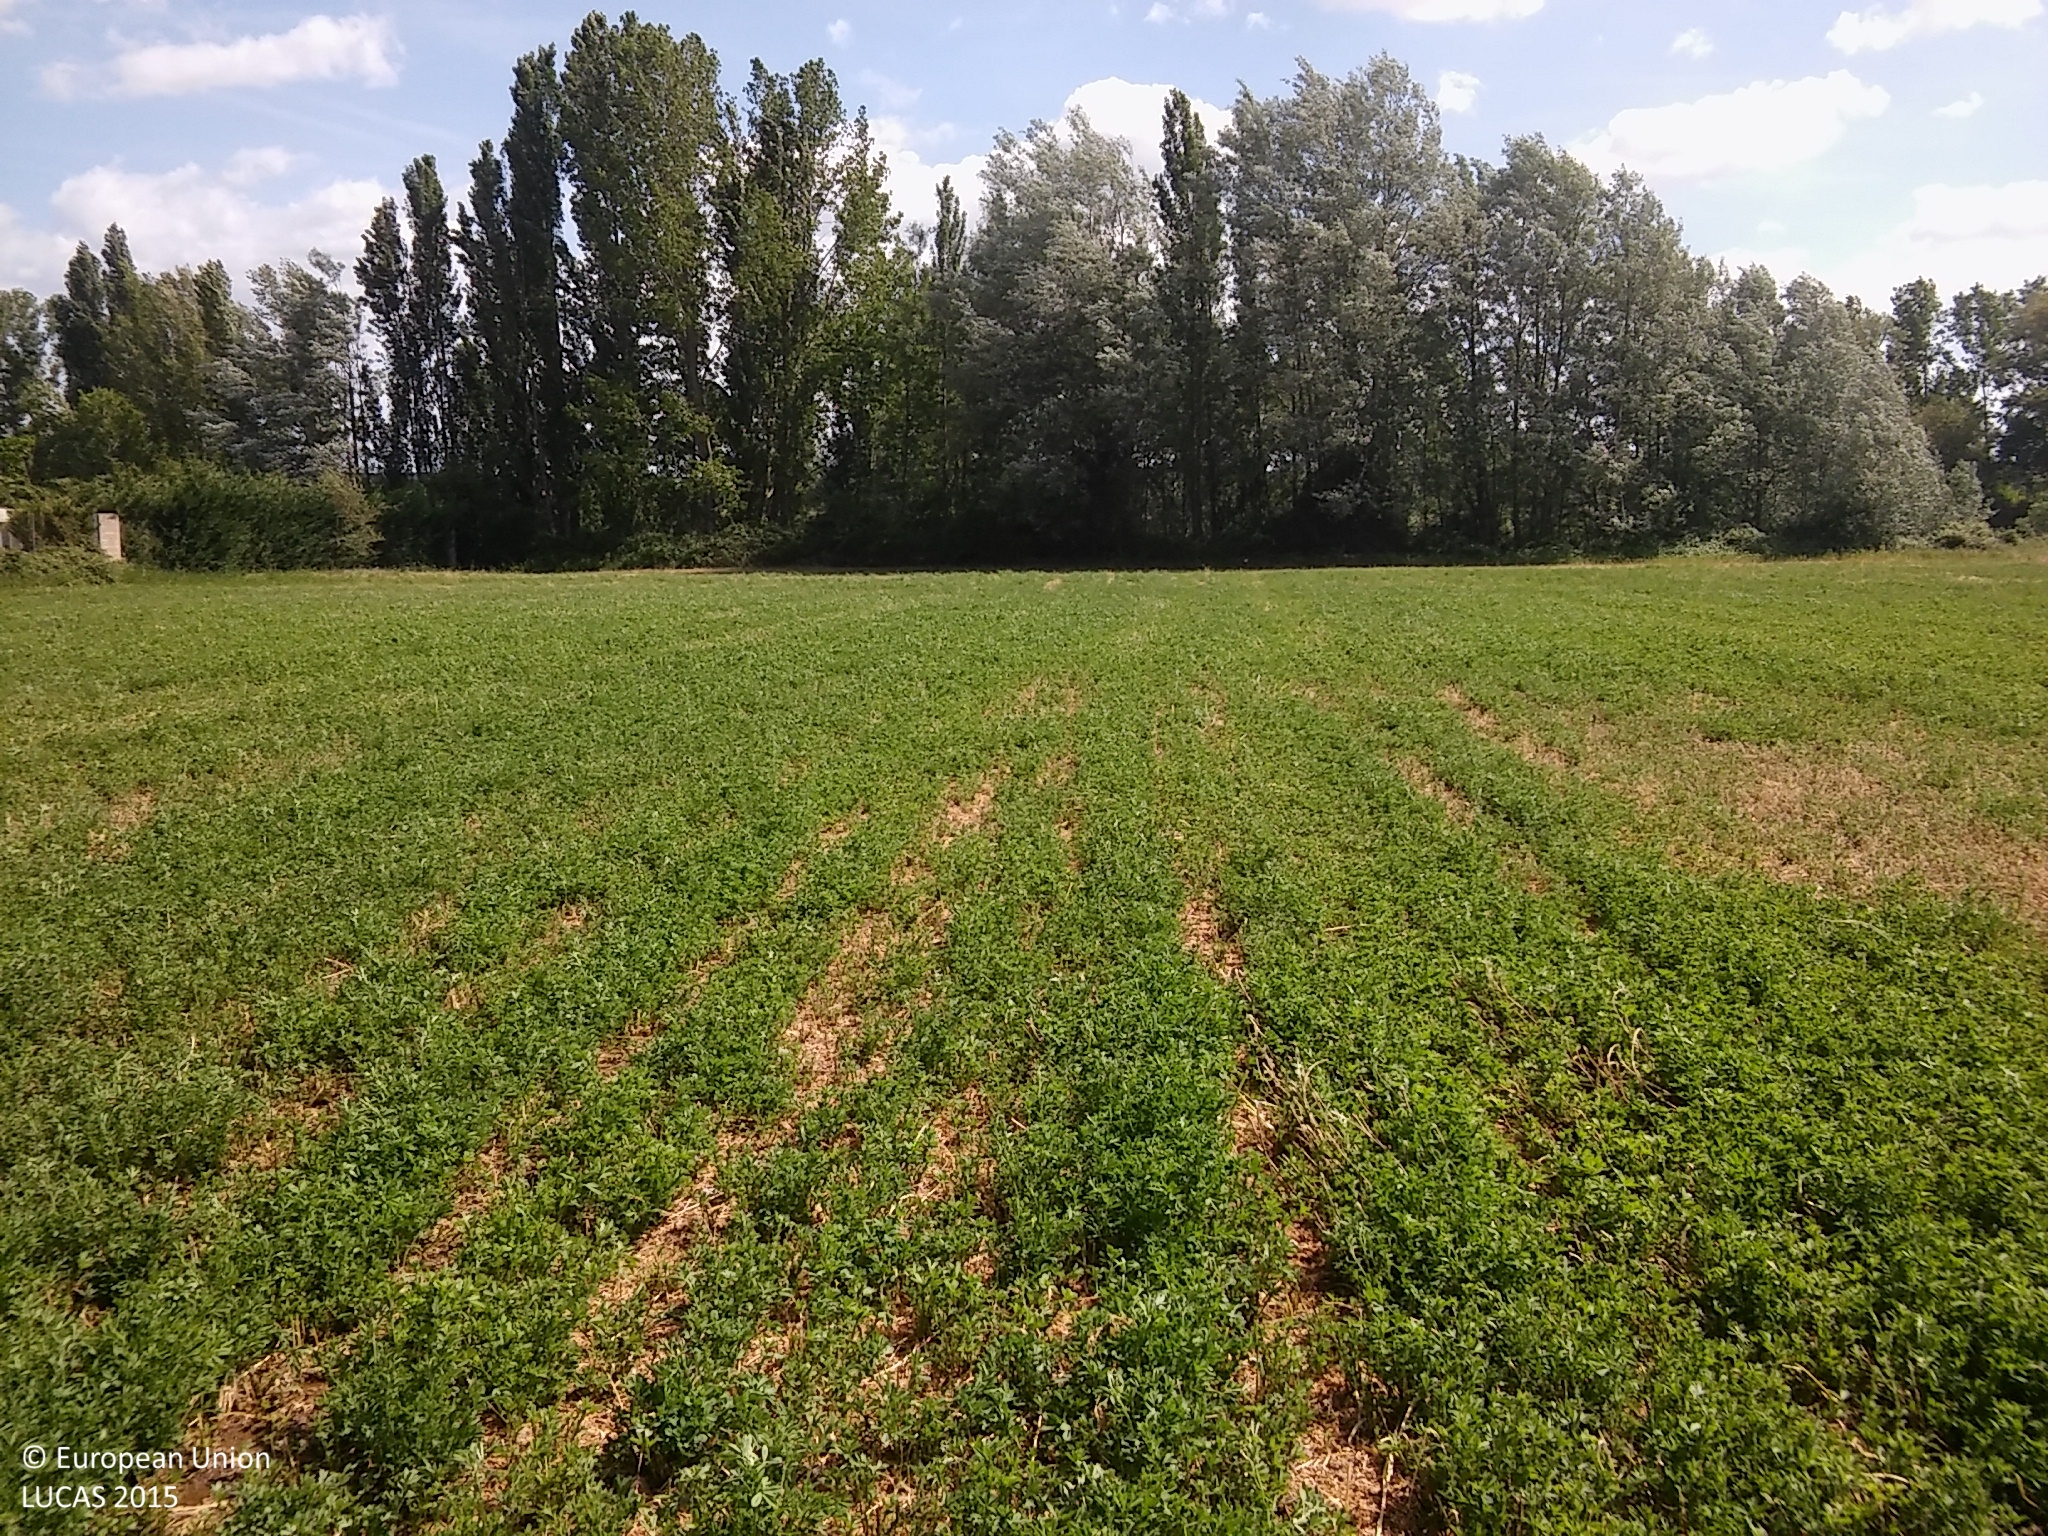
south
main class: Cropland
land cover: Lucerne
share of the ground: 25 - 50 %
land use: Agriculture (excluding fallow land and kitchen gardens)
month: May
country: ES
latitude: 41.6510
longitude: -3.6565
